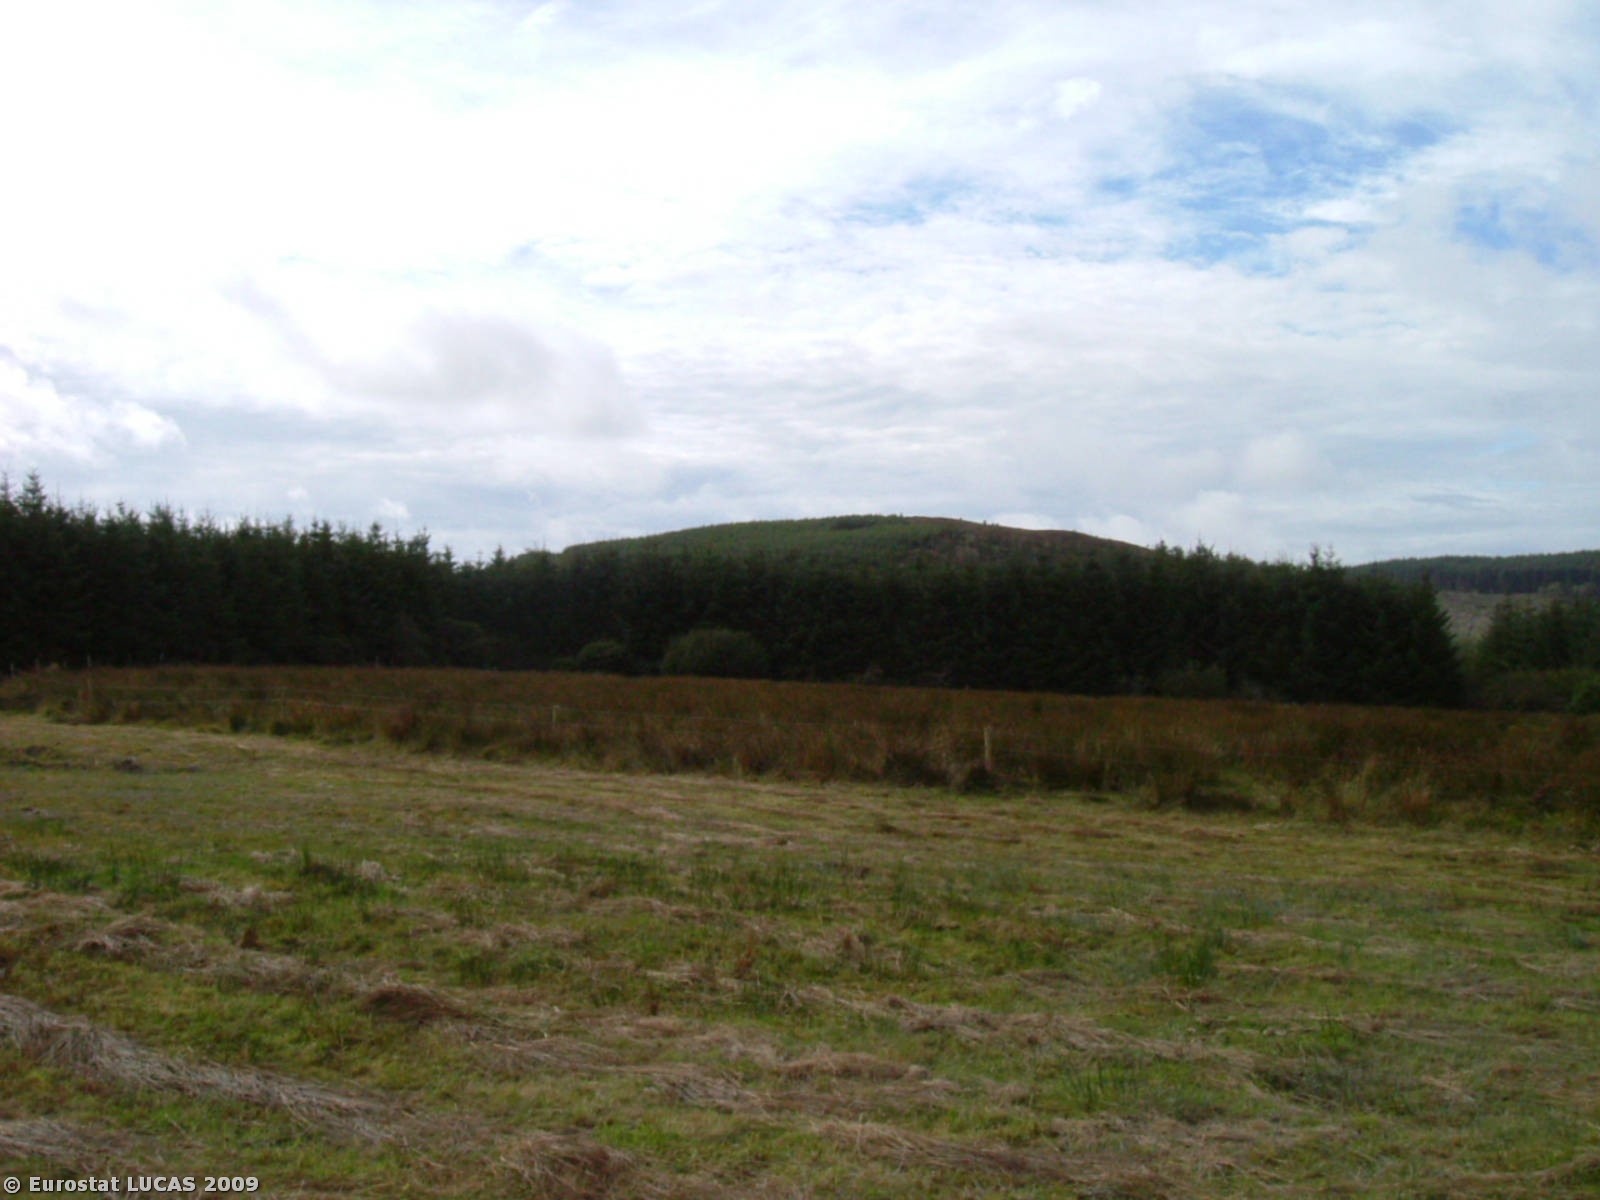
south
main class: Grassland
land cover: Grassland without tree/shrub cover
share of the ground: > 75 %
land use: Agriculture (excluding fallow land and kitchen gardens)
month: September
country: IE
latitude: 52.8497
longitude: -8.3487
